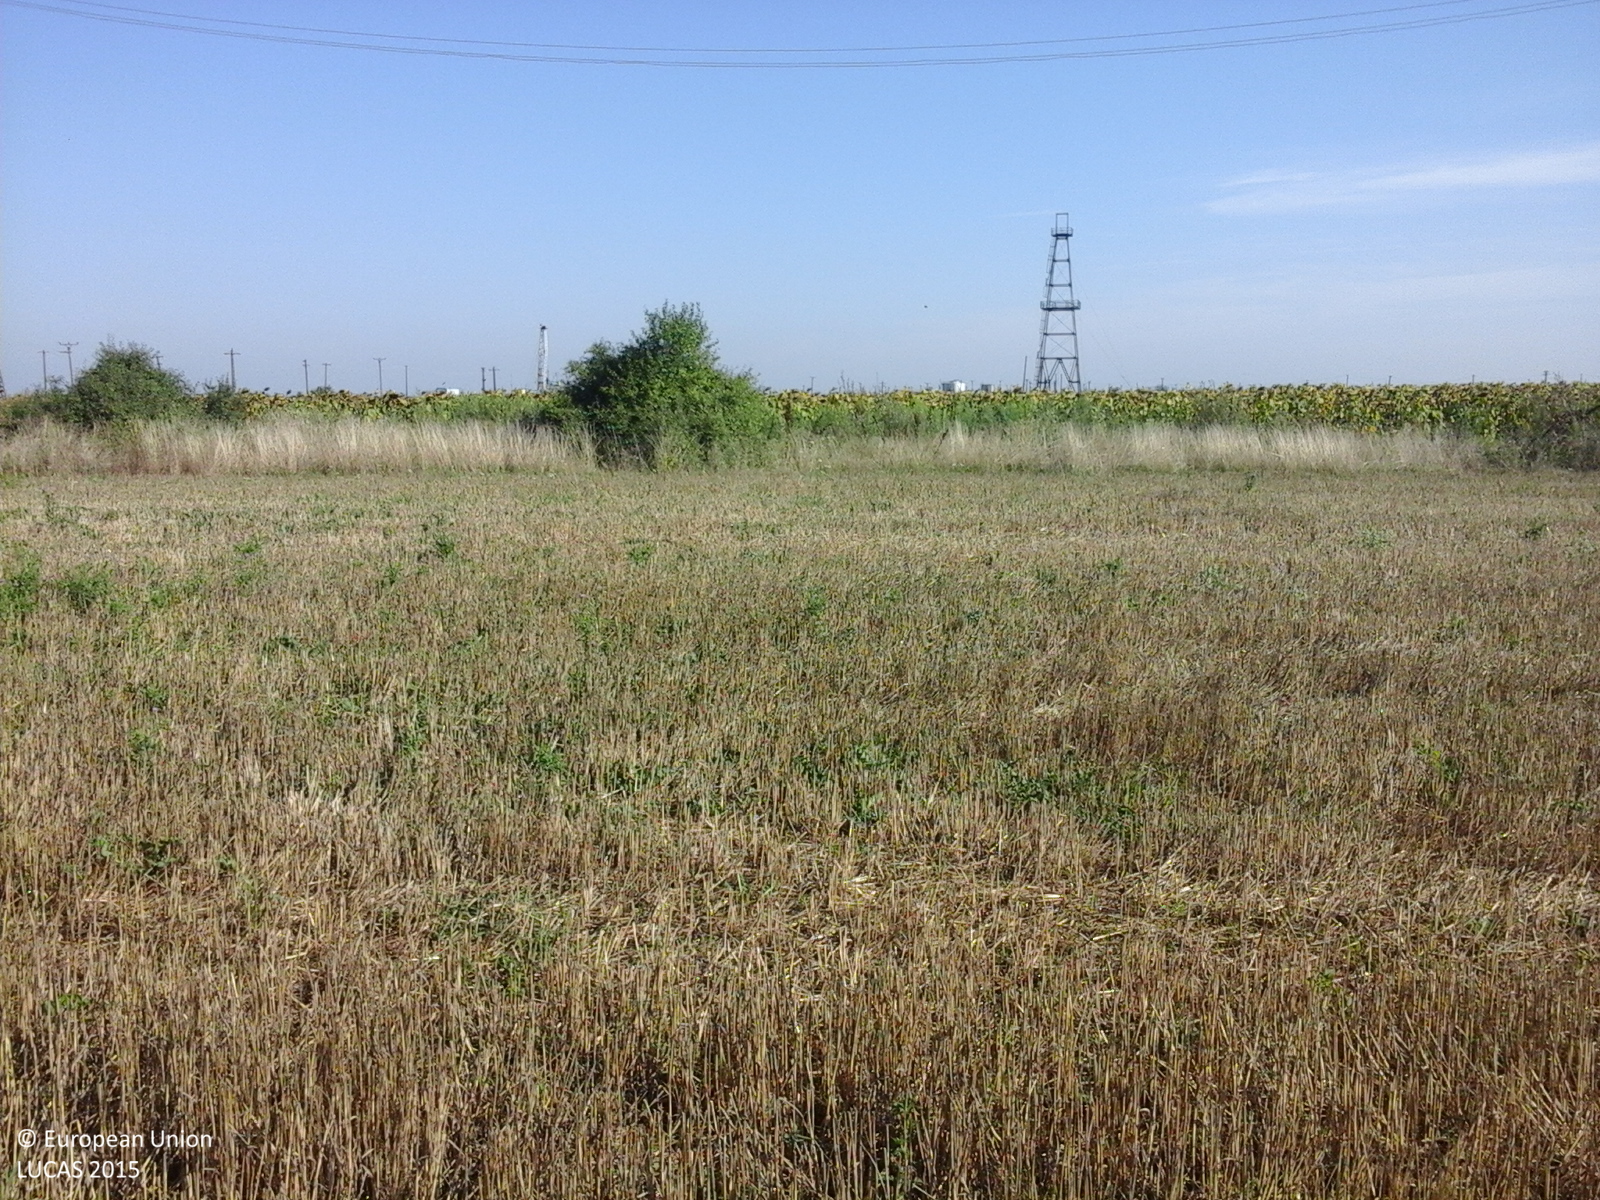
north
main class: Cropland
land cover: Common wheat
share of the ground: 25 - 50 %
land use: Agriculture (excluding fallow land and kitchen gardens)
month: August
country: RO
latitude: 45.8221
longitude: 21.1378
